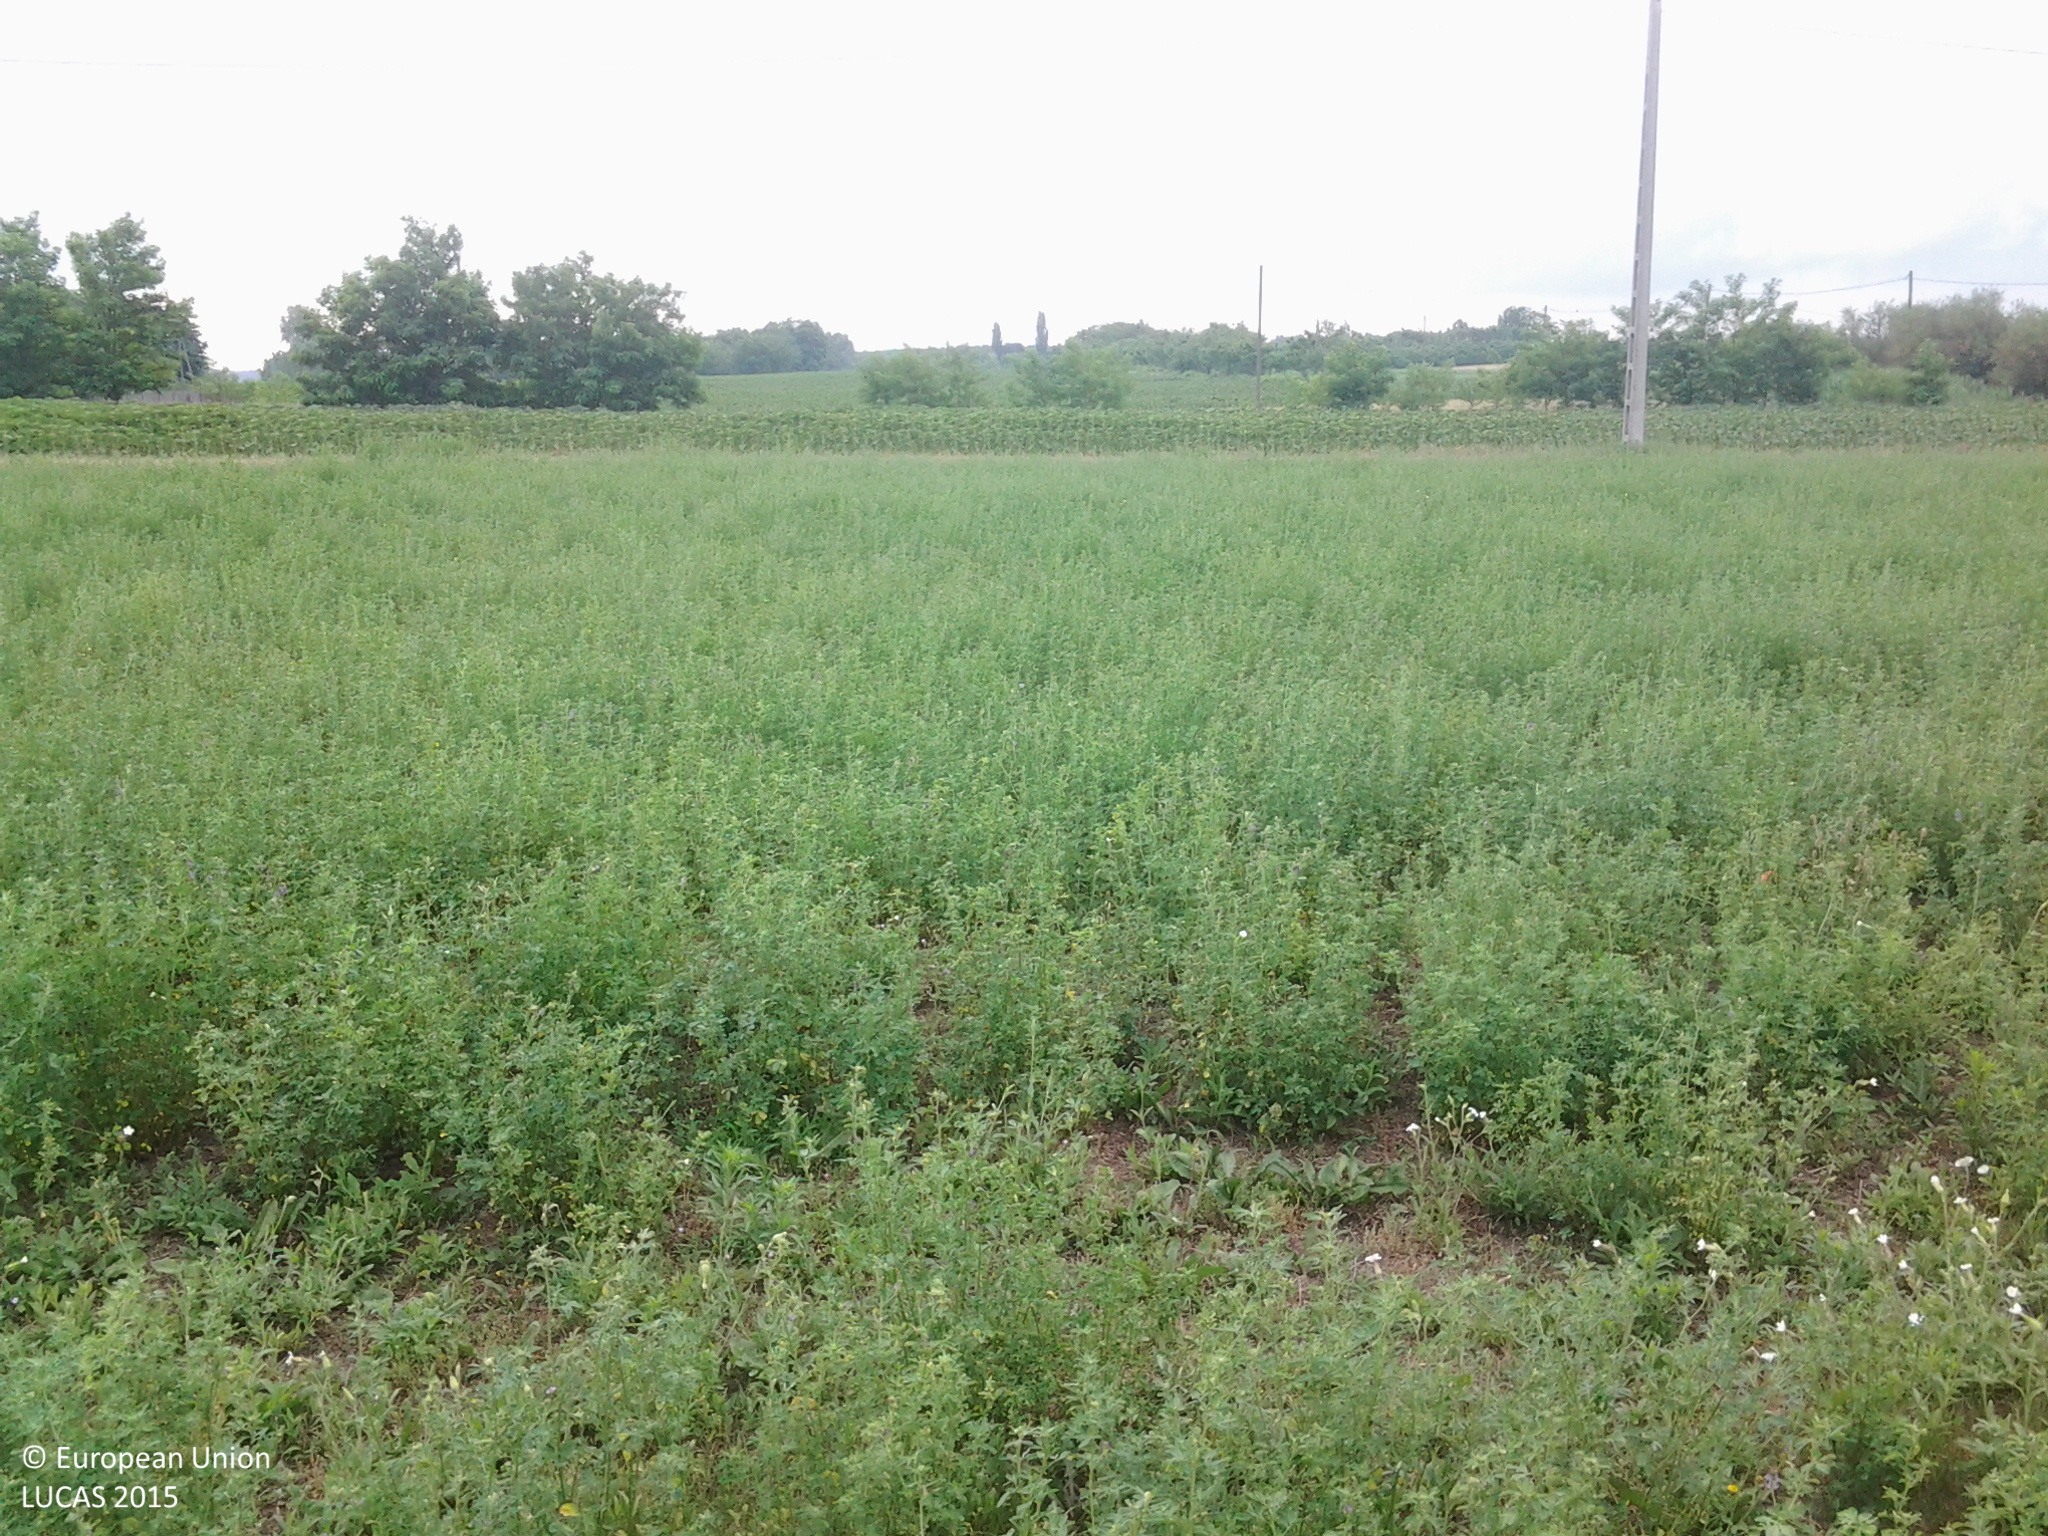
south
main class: Cropland
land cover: Lucerne
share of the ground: > 75 %
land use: Agriculture (excluding fallow land and kitchen gardens)
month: June
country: HU
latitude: 47.0008
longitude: 19.6608
